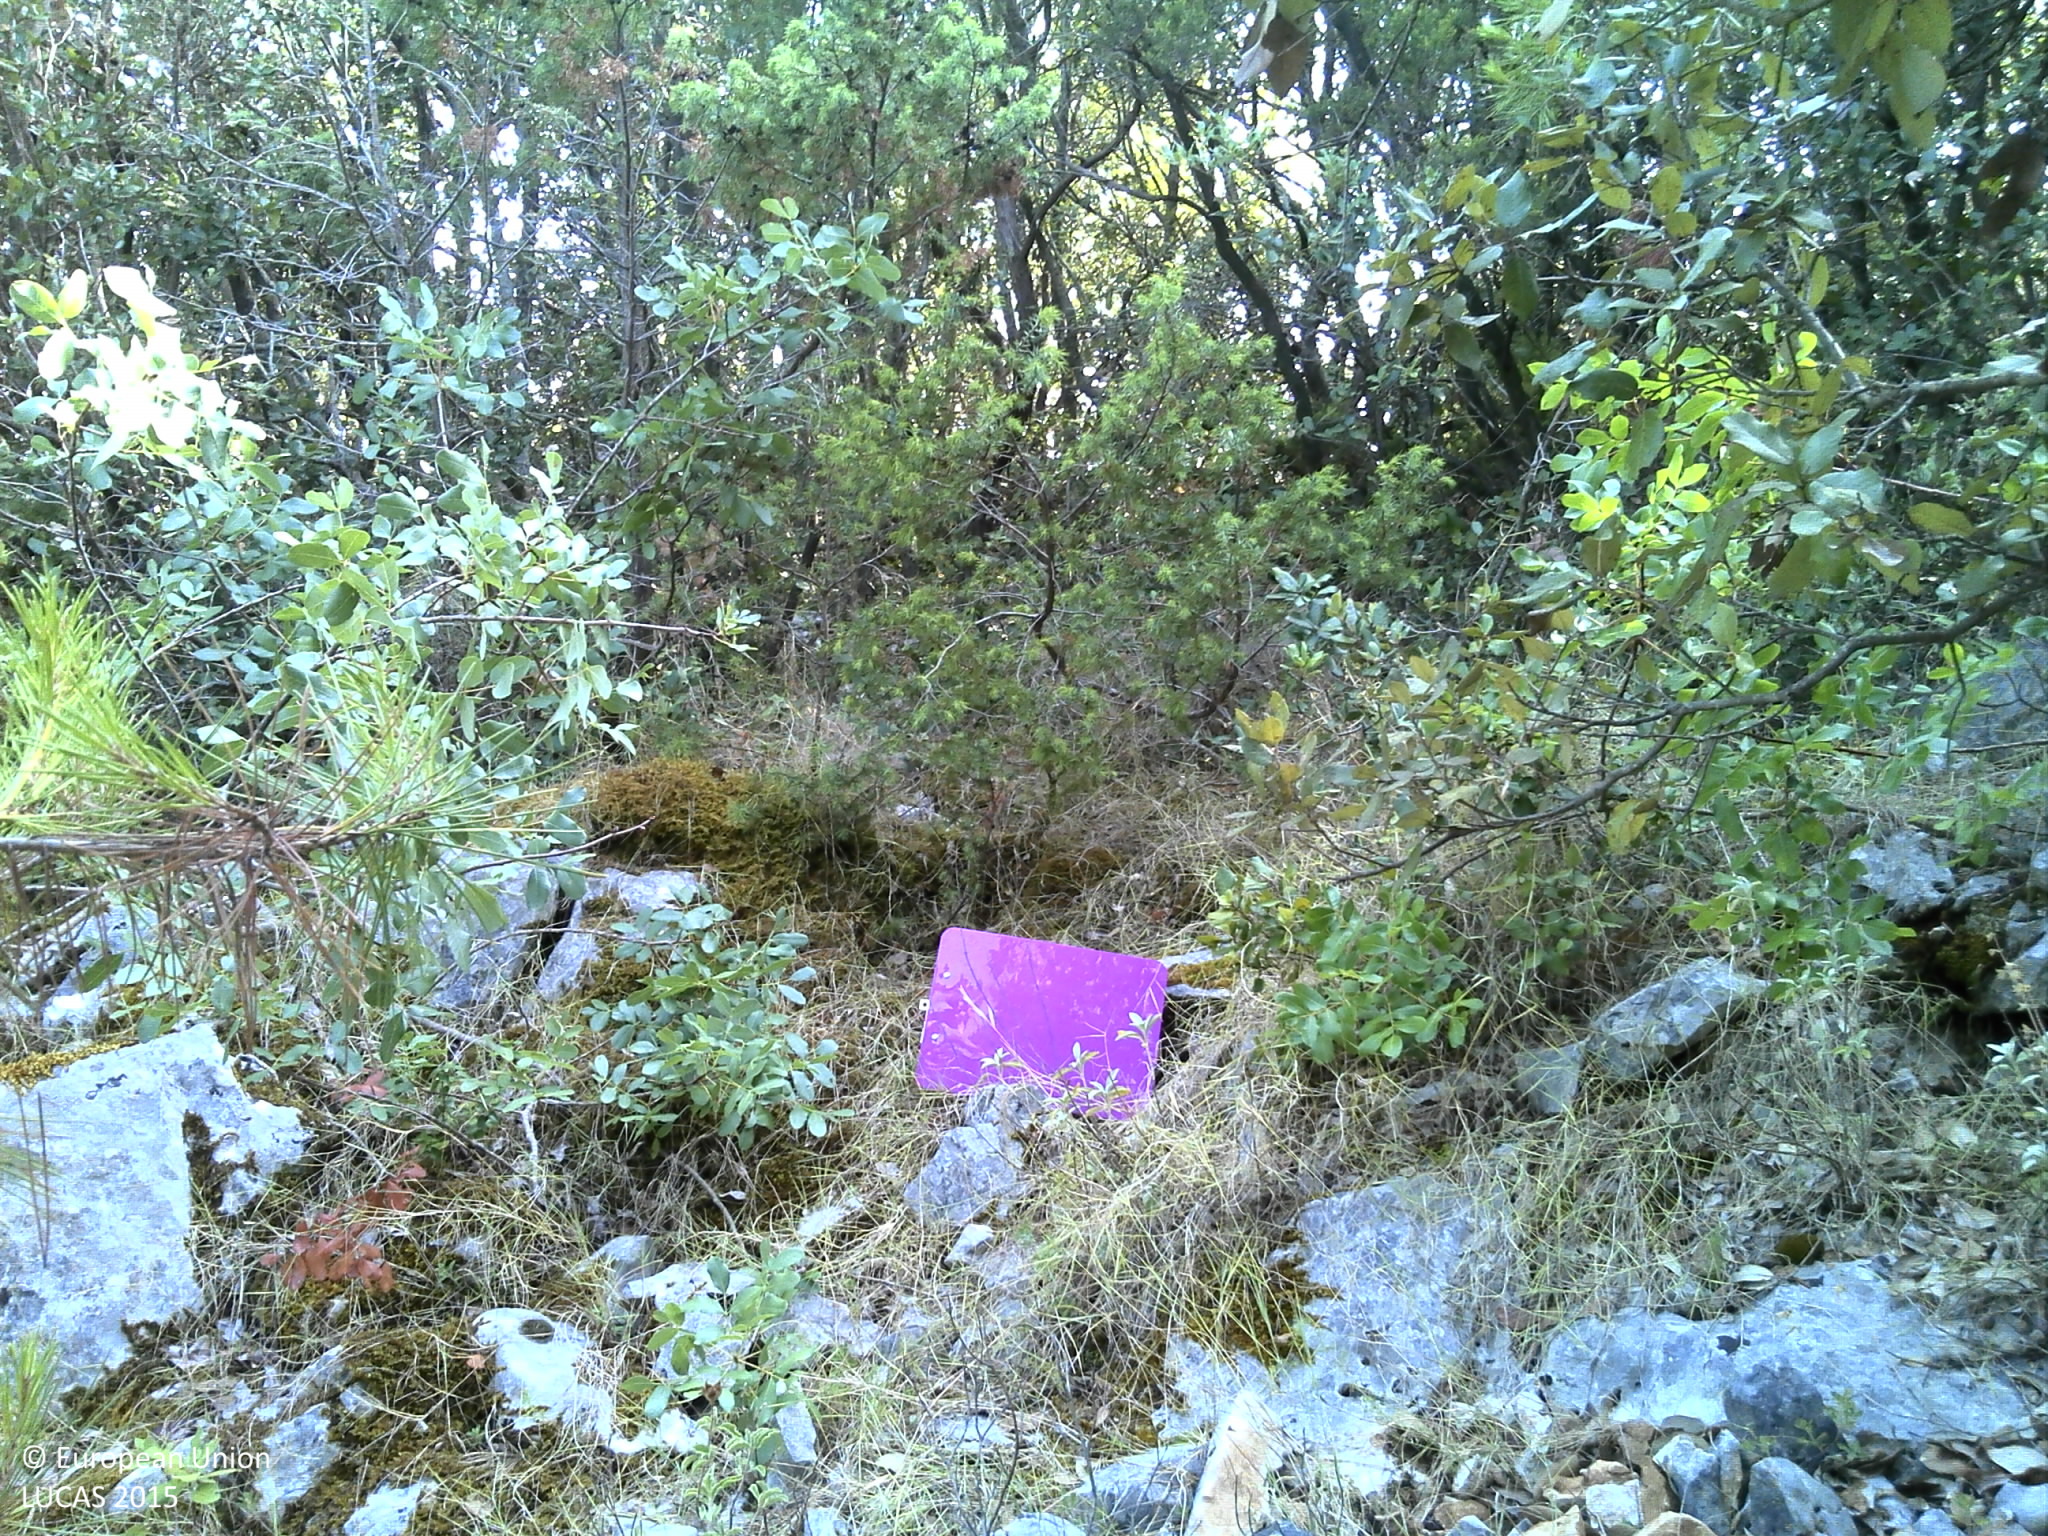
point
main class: Shrubland
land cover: Shrubland with sparse tree cover
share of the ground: > 75 %
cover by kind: shrubs 75 %, broadleaved forest trees 5 %, herbaceous plants 5 %, lichens and mosses 5 %, consolidated bare surface 5 %, unconsolidated bare surface 5 %
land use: Semi-natural and natural areas not in use
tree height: < 5 m
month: August
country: HR
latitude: 43.1390
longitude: 16.9609
